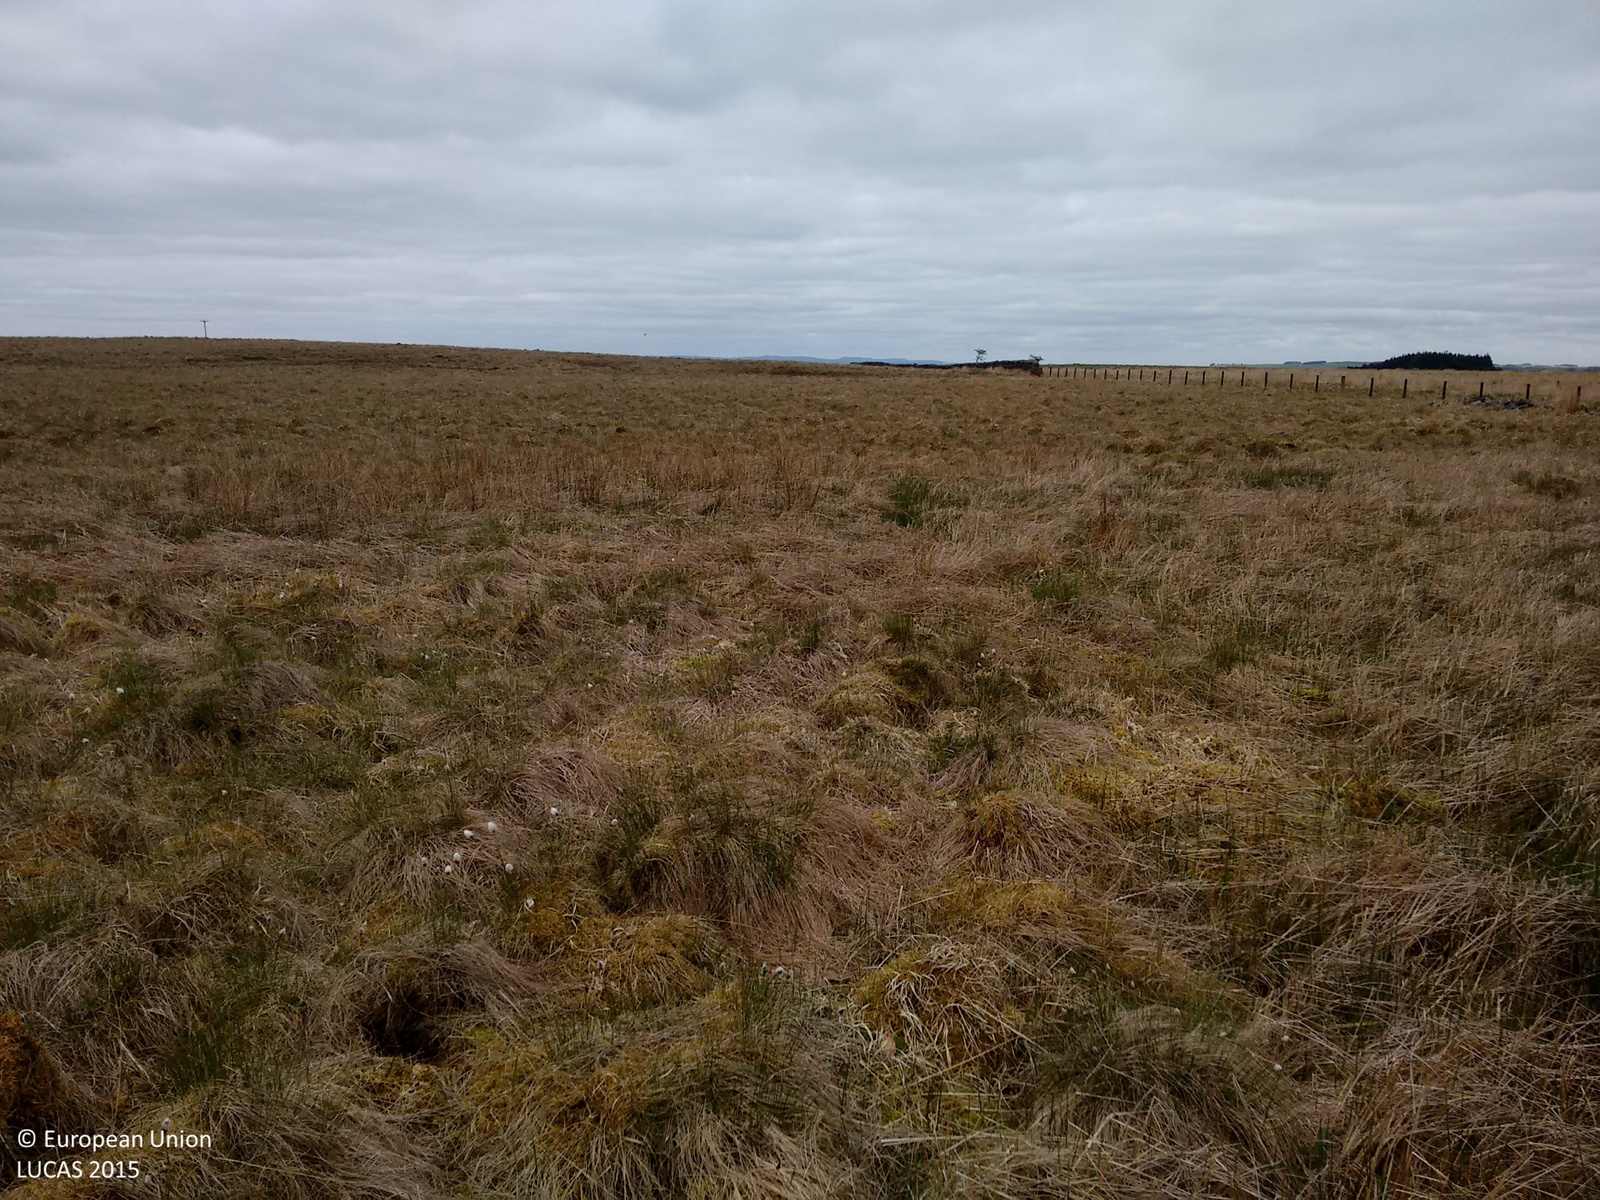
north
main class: Grassland
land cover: Grassland without tree/shrub cover
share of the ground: > 75 %
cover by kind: herbaceous plants 100 %
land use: Agriculture (excluding fallow land and kitchen gardens)
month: May
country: GB
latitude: 55.0168
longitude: -2.0508
